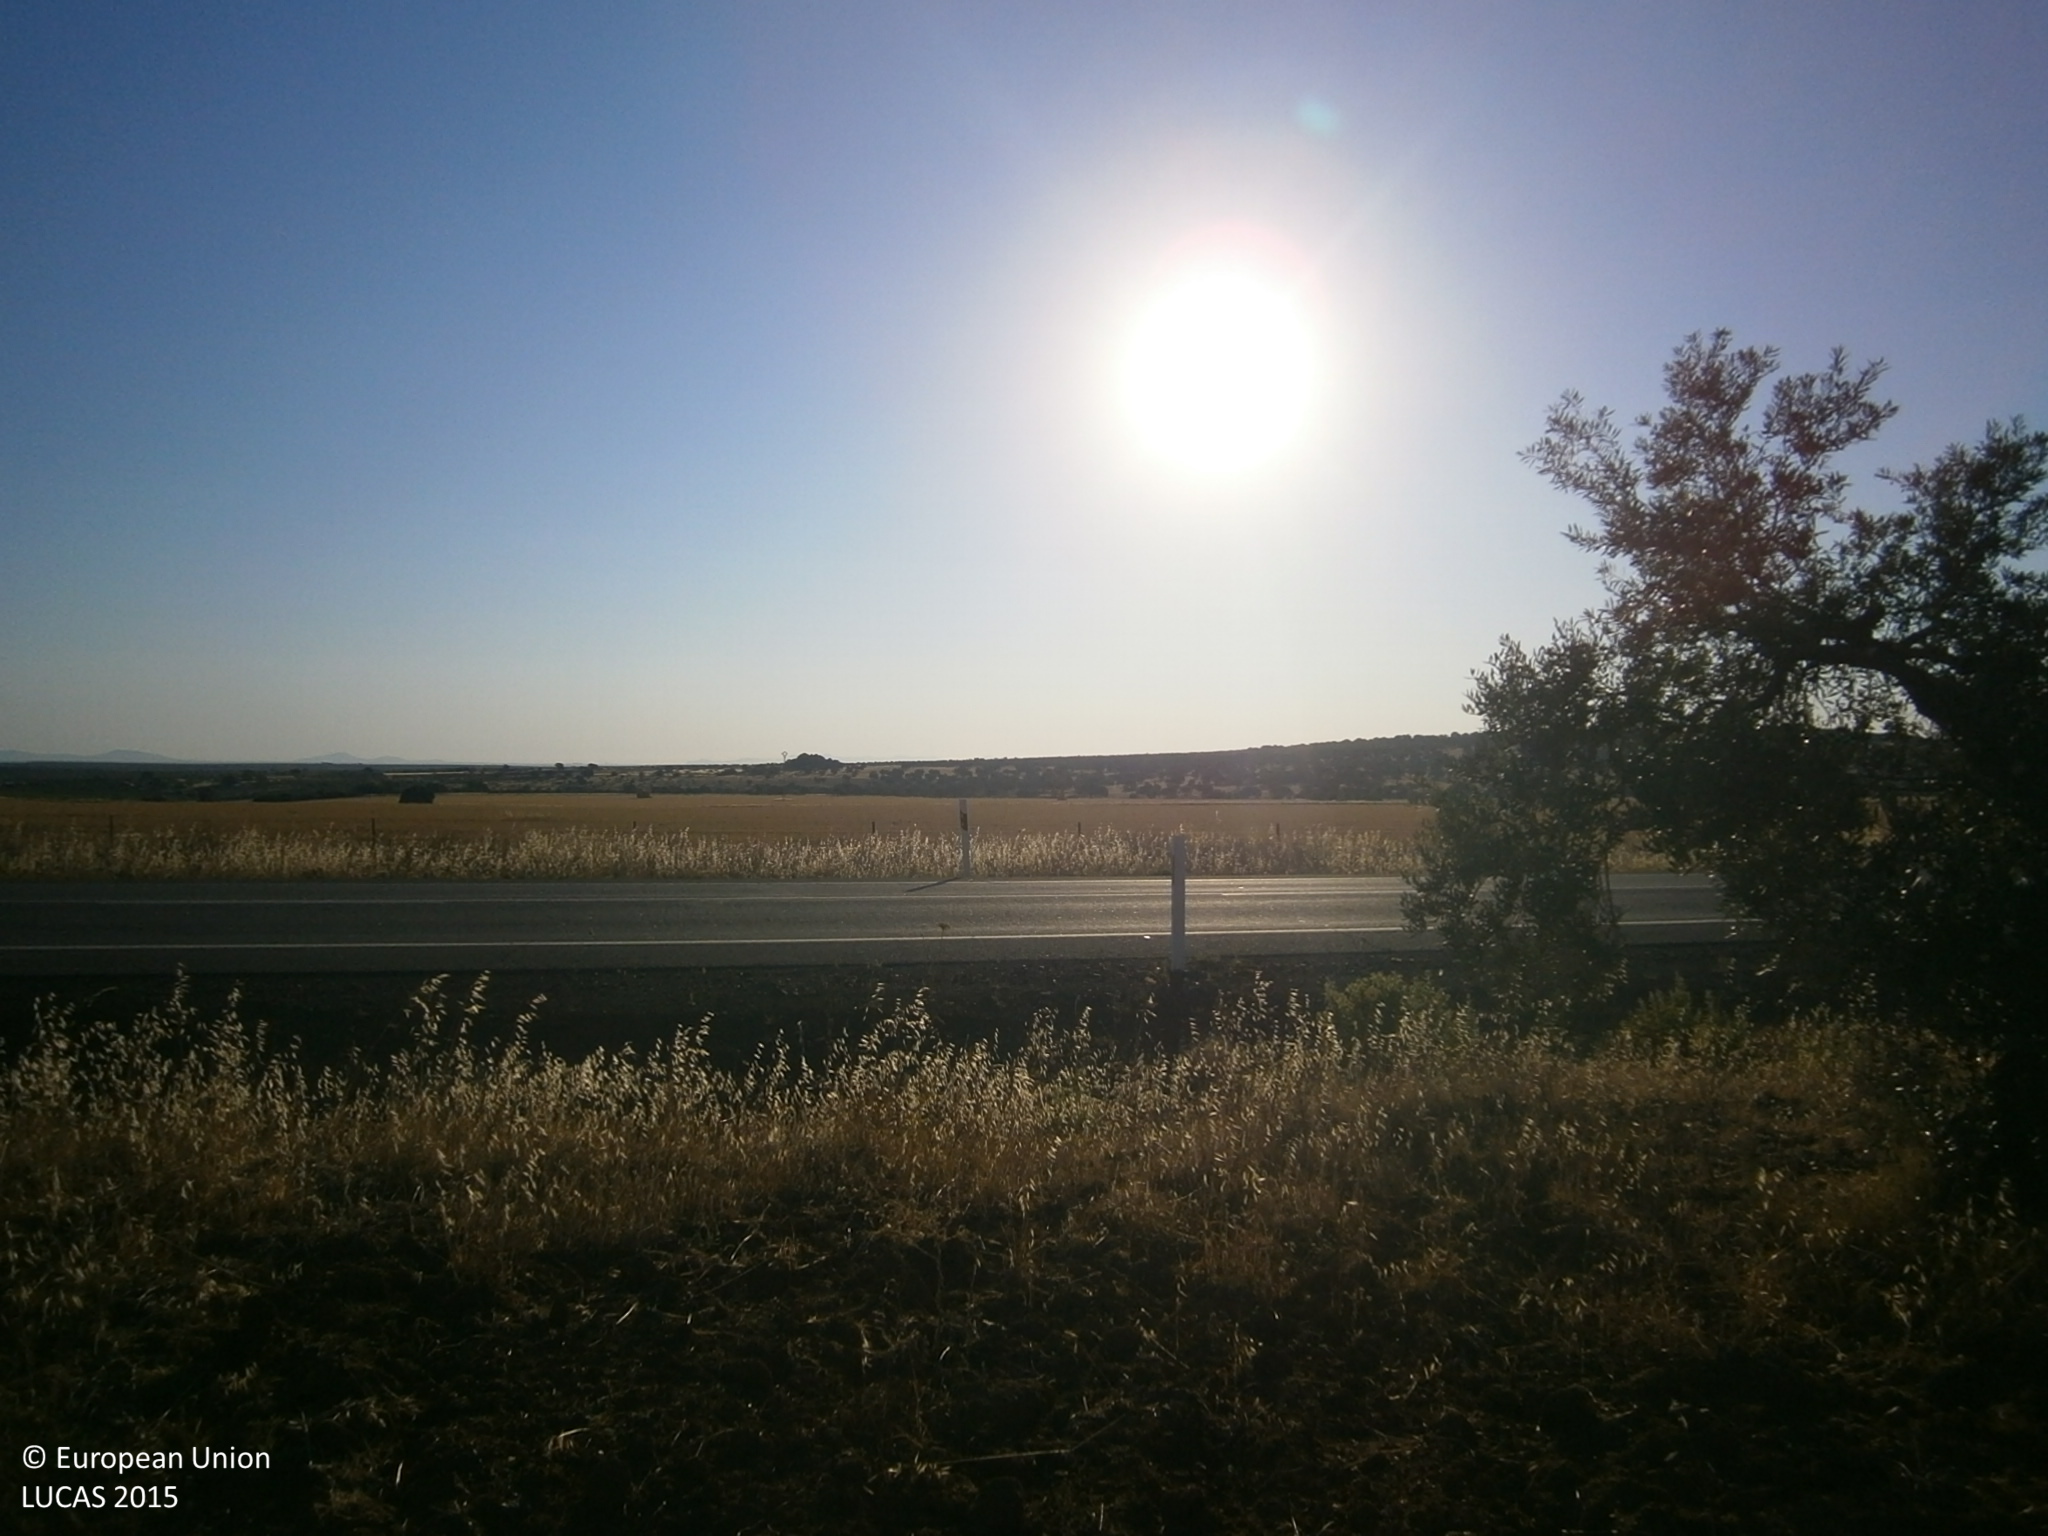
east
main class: Cropland
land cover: Olive groves
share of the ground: 10 - 25 %
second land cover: Other bare soil
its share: > 75 %
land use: Agriculture (excluding fallow land and kitchen gardens)
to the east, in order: Olive groves; Other bare soil; Spontaneously vegetated surfaces; Paved roads, cycling and walking lanes; Spontaneously vegetated surfaces; Fences; Other bare soil
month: June
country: ES
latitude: 38.5841
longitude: -6.5991
